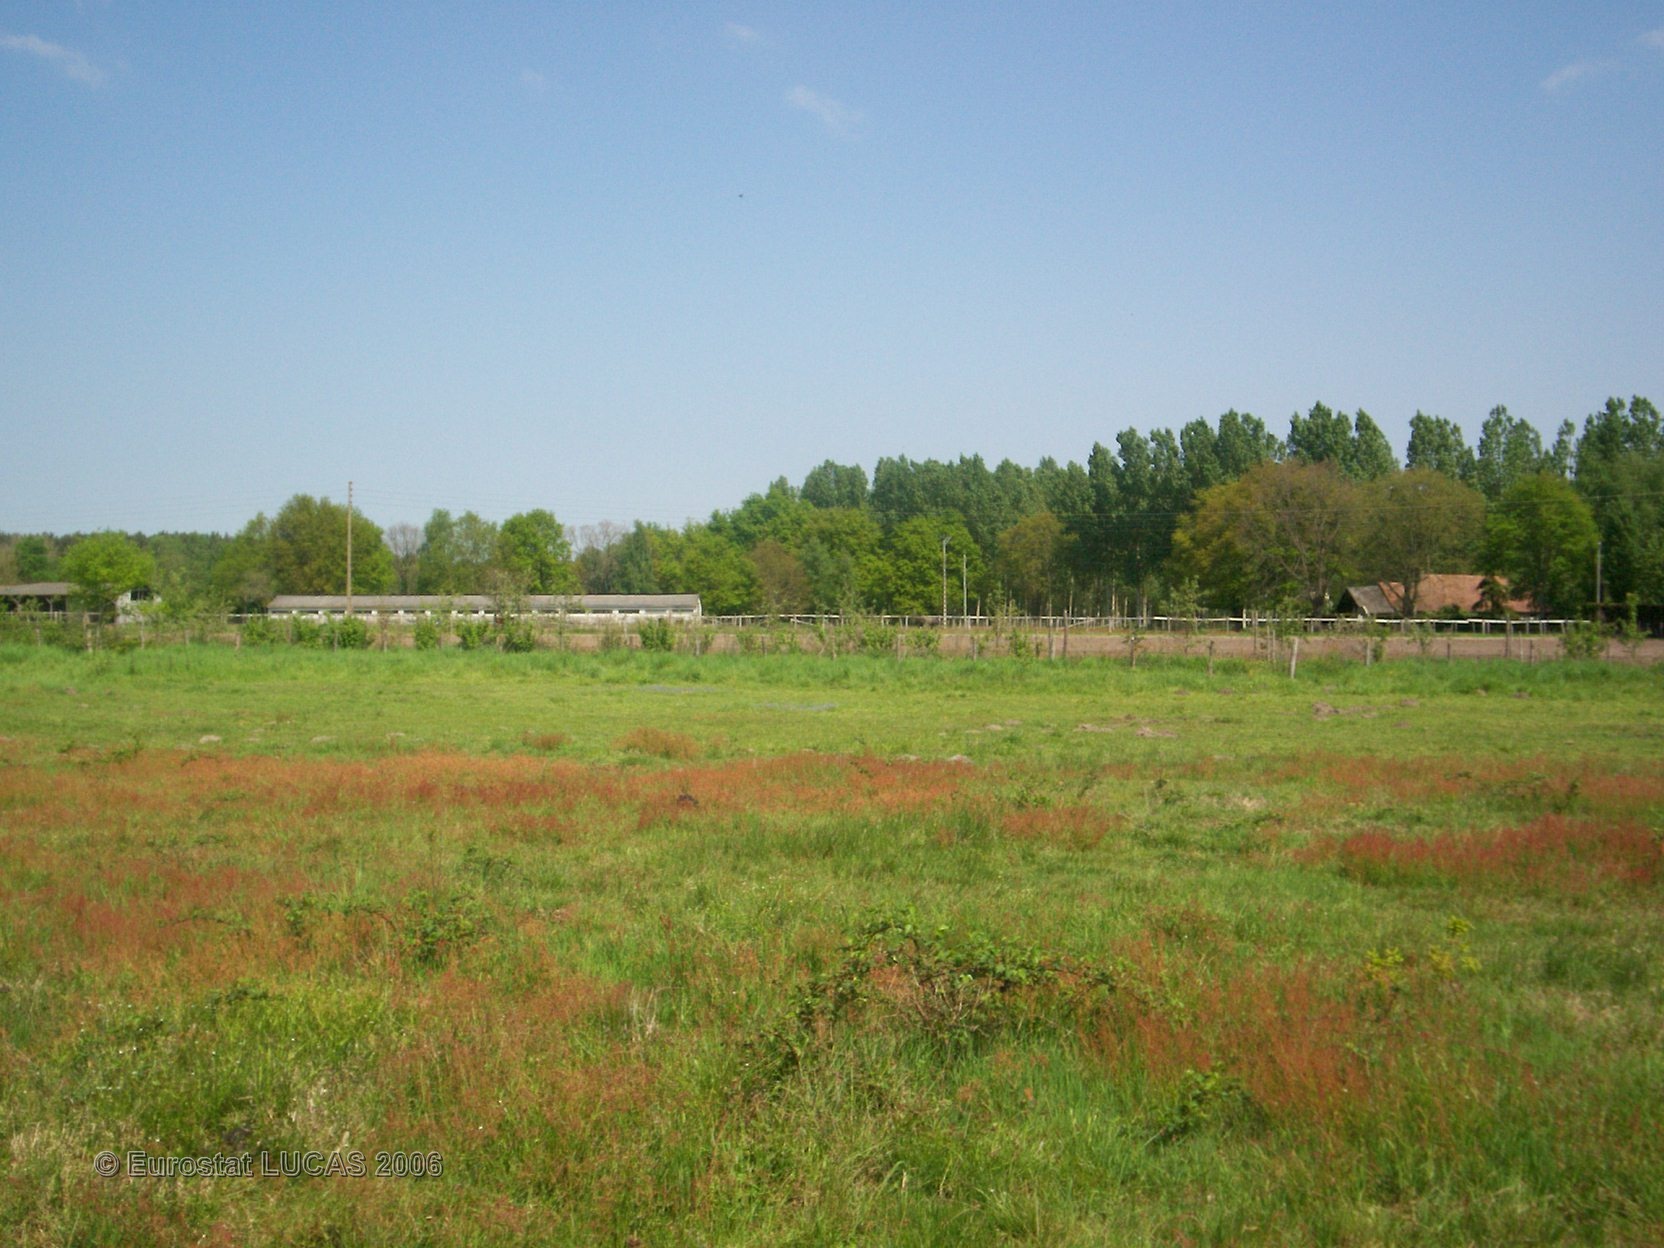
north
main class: Grassland
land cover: Grassland without tree/shrub cover
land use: Agriculture (excluding fallow land and kitchen gardens)
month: May
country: FR
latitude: 47.7673
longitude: 0.1945
